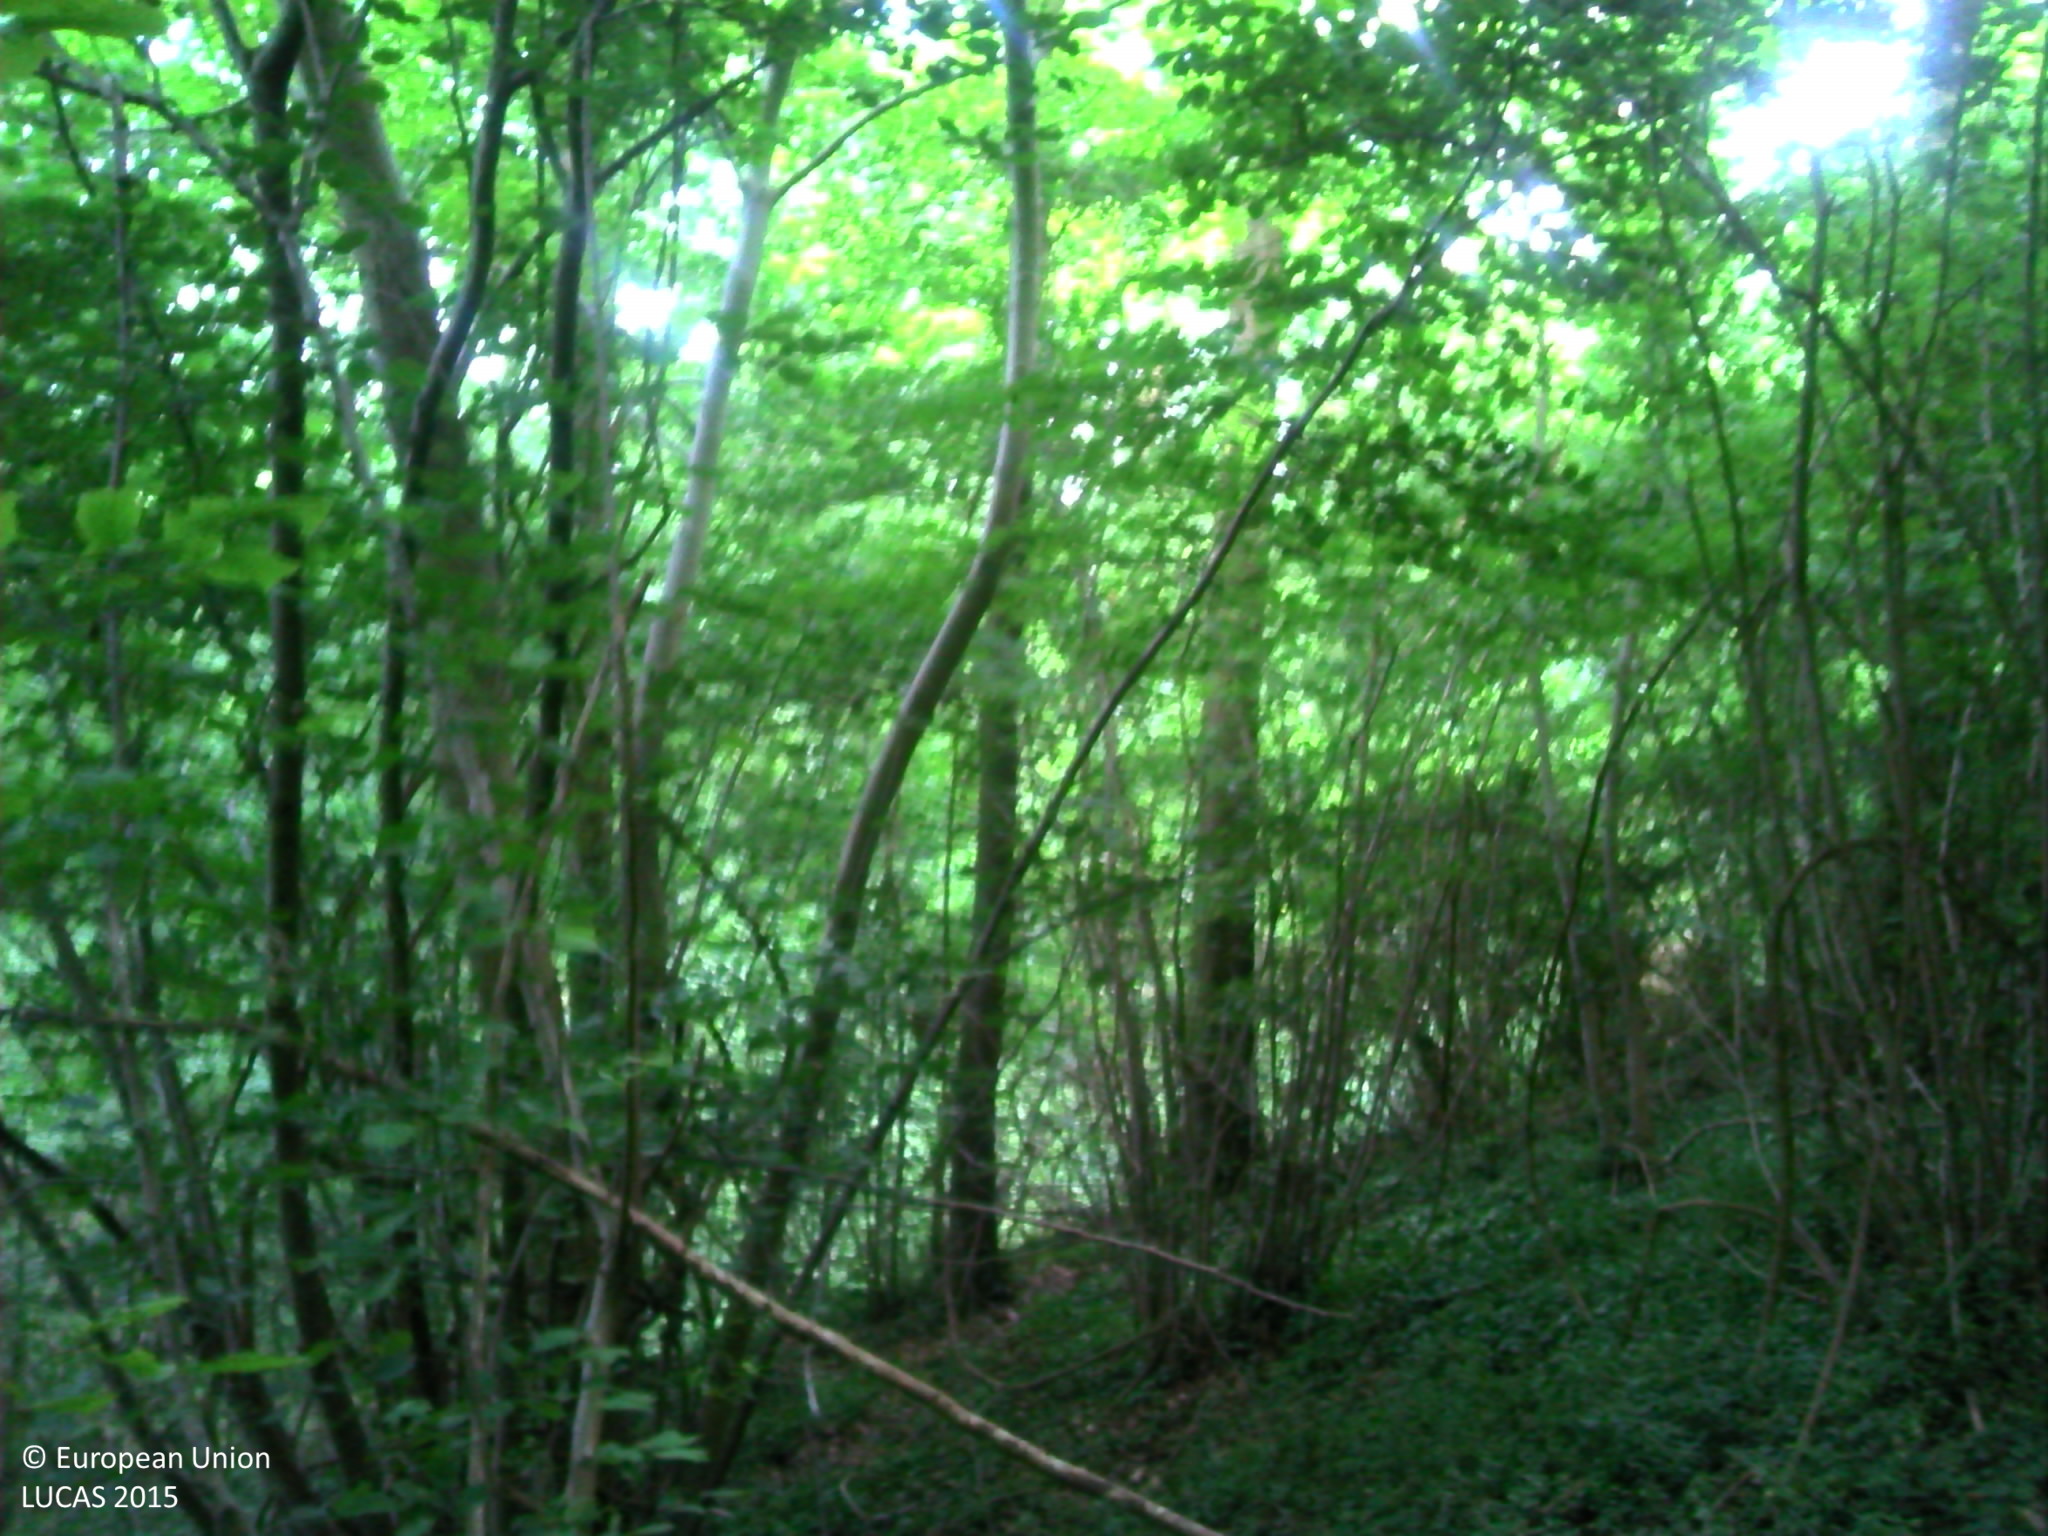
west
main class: Woodland
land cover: Broadleaved woodland
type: mesophytic deciduous forest
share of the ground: > 75 %
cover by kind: broadleaved forest trees 85 %, shrubs 10 %, lichens and mosses 5 %
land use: Forestry
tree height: > 5 m
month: June
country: FR
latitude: 49.5118
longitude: 2.9049
